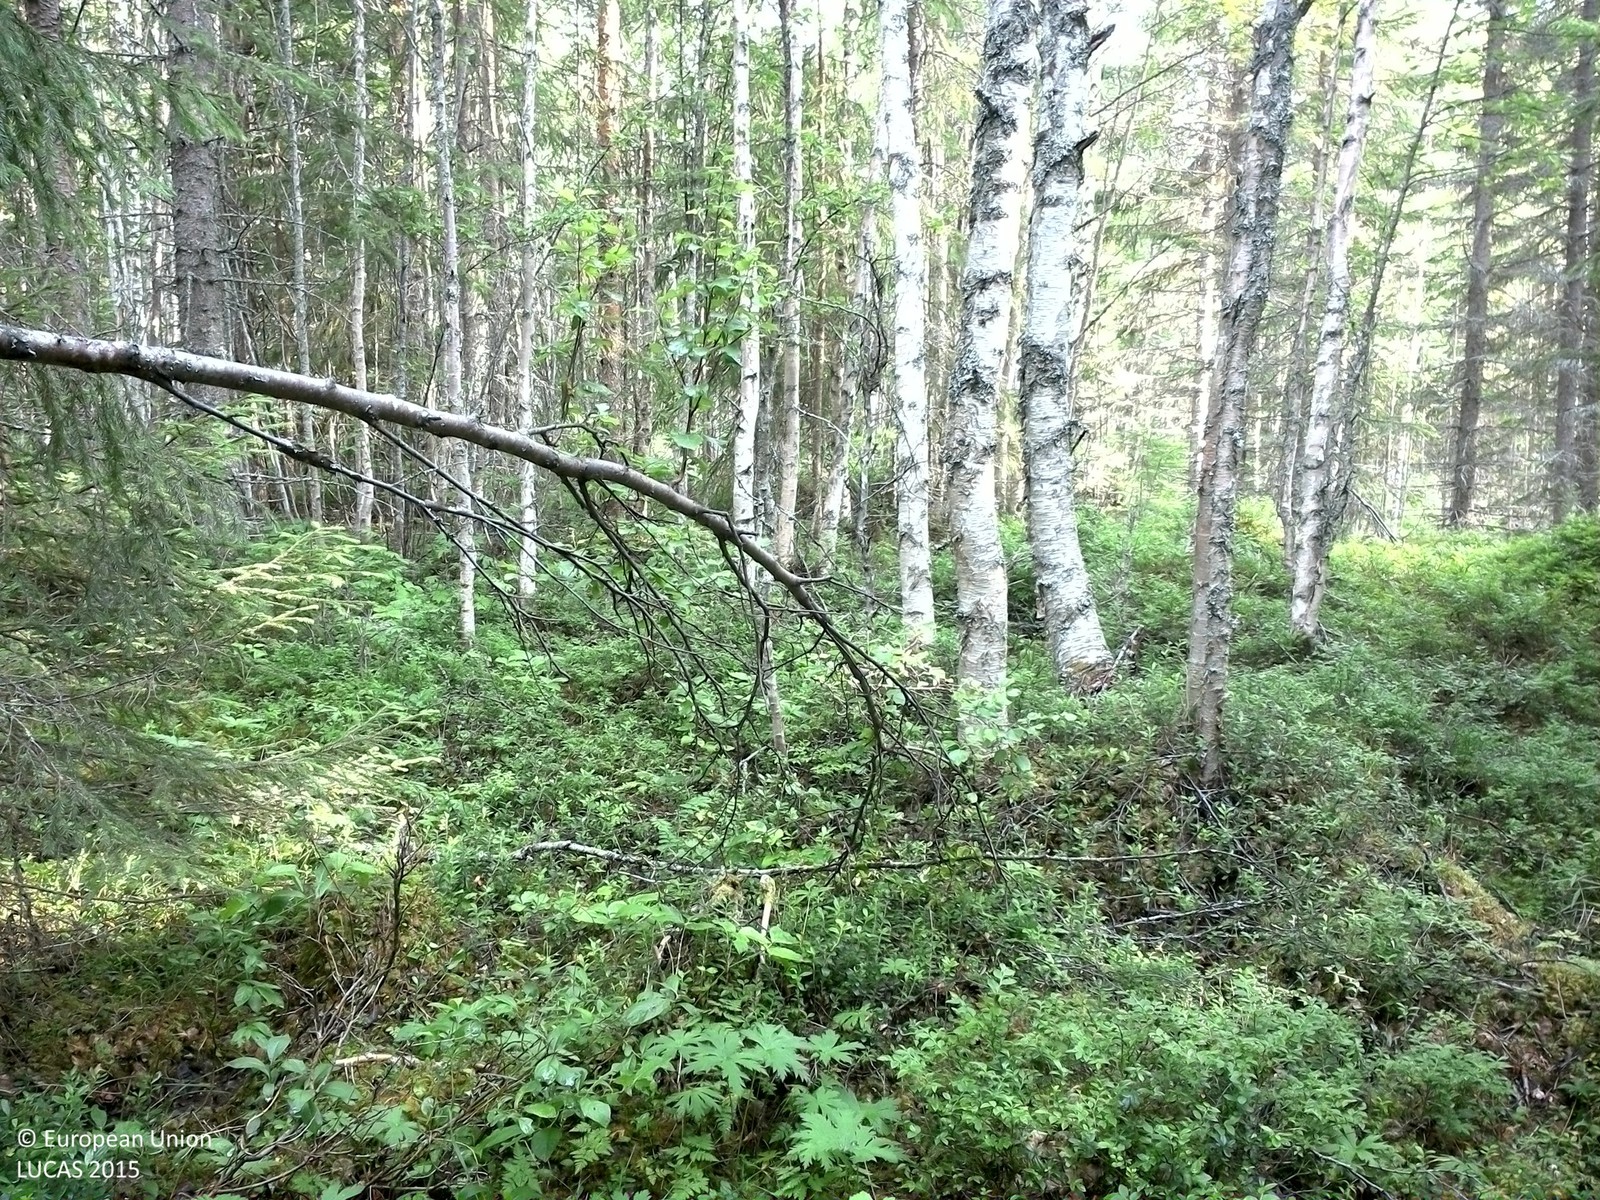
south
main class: Woodland
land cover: Spruce dominated mixed woodland
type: boreal forest
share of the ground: 50 - 75 %
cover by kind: coniferous forest trees 45 %, broadleaved forest trees 25 %, shrubs 10 %, herbaceous plants 10 %, lichens and mosses 10 %
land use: Forestry
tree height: > 5 m
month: August
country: SE
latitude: 63.5868
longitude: 16.6828
